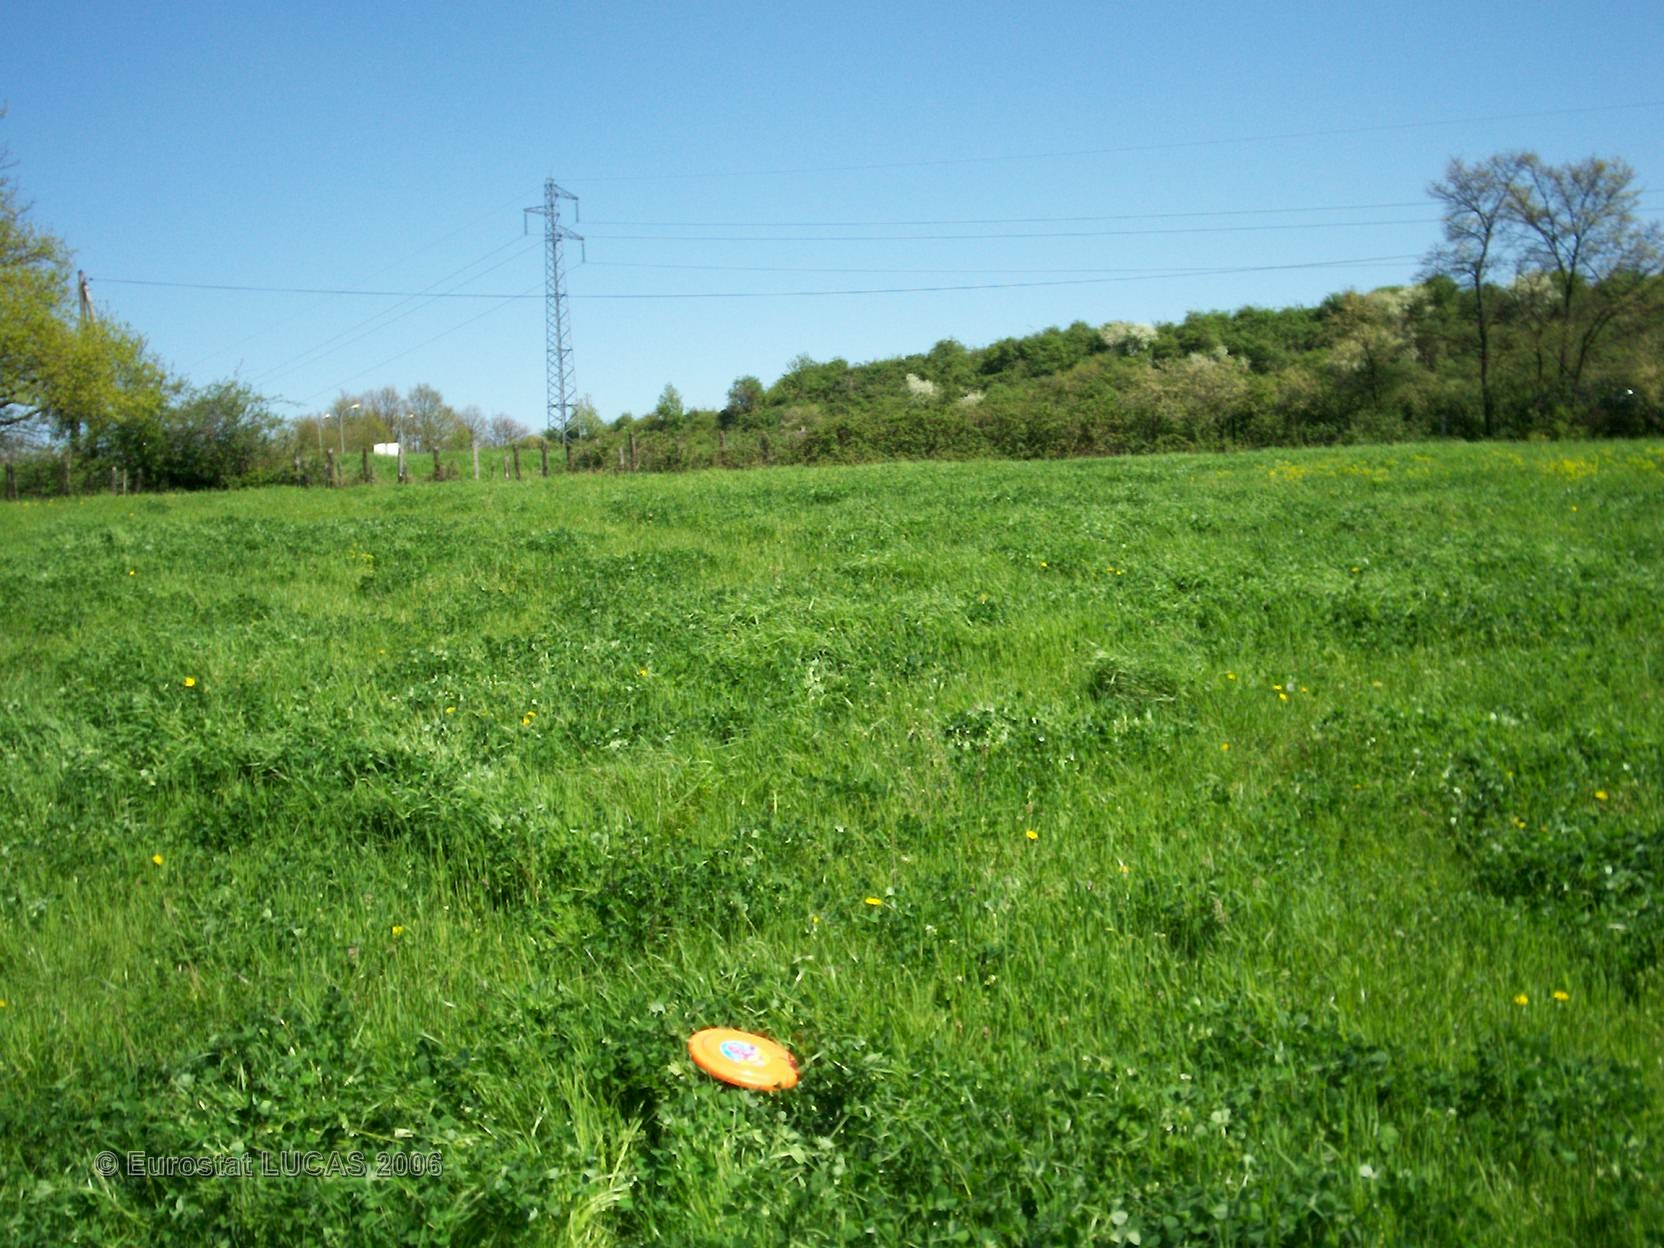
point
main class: Grassland
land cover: Grassland without tree/shrub cover
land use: Agriculture (excluding fallow land and kitchen gardens)
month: April
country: FR
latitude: 45.5936
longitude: 4.8123
